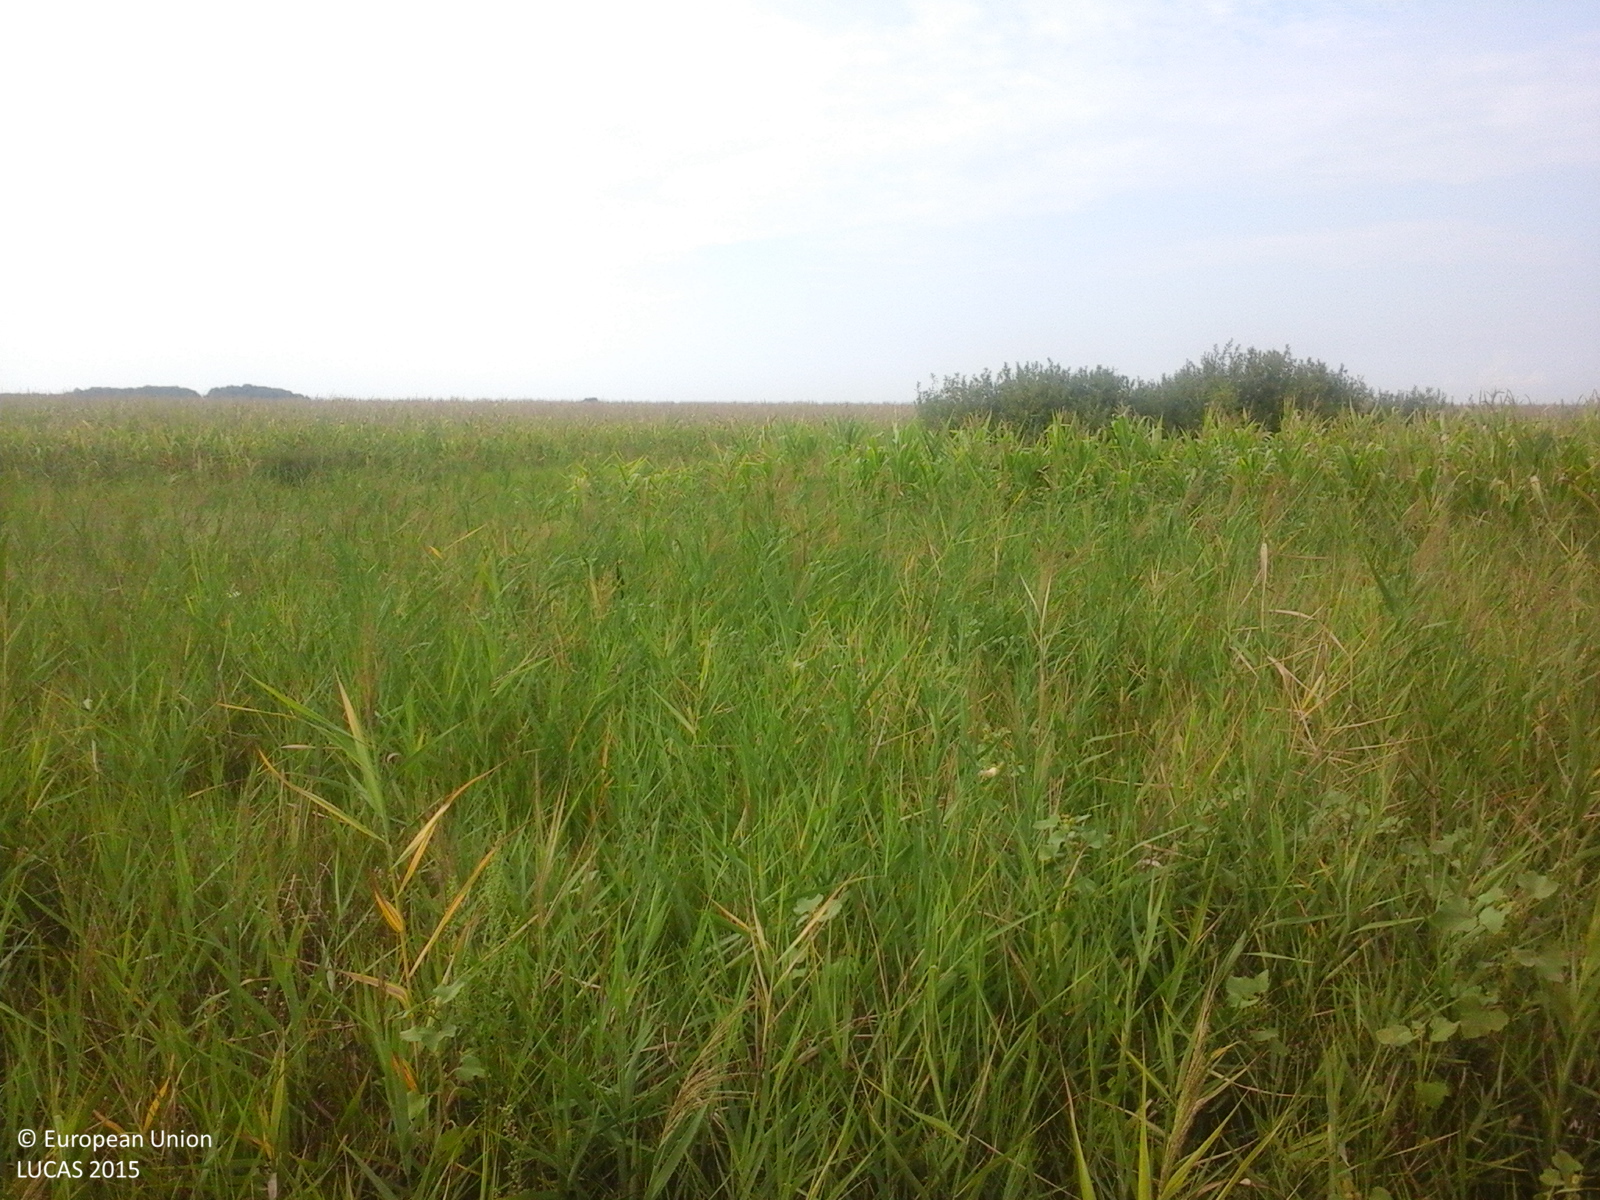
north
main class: Grassland
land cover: Spontaneously vegetated surfaces
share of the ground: > 75 %
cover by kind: herbaceous plants 100 %
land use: Agriculture (excluding fallow land and kitchen gardens)
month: August
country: RO
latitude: 46.5514
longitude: 21.7931
